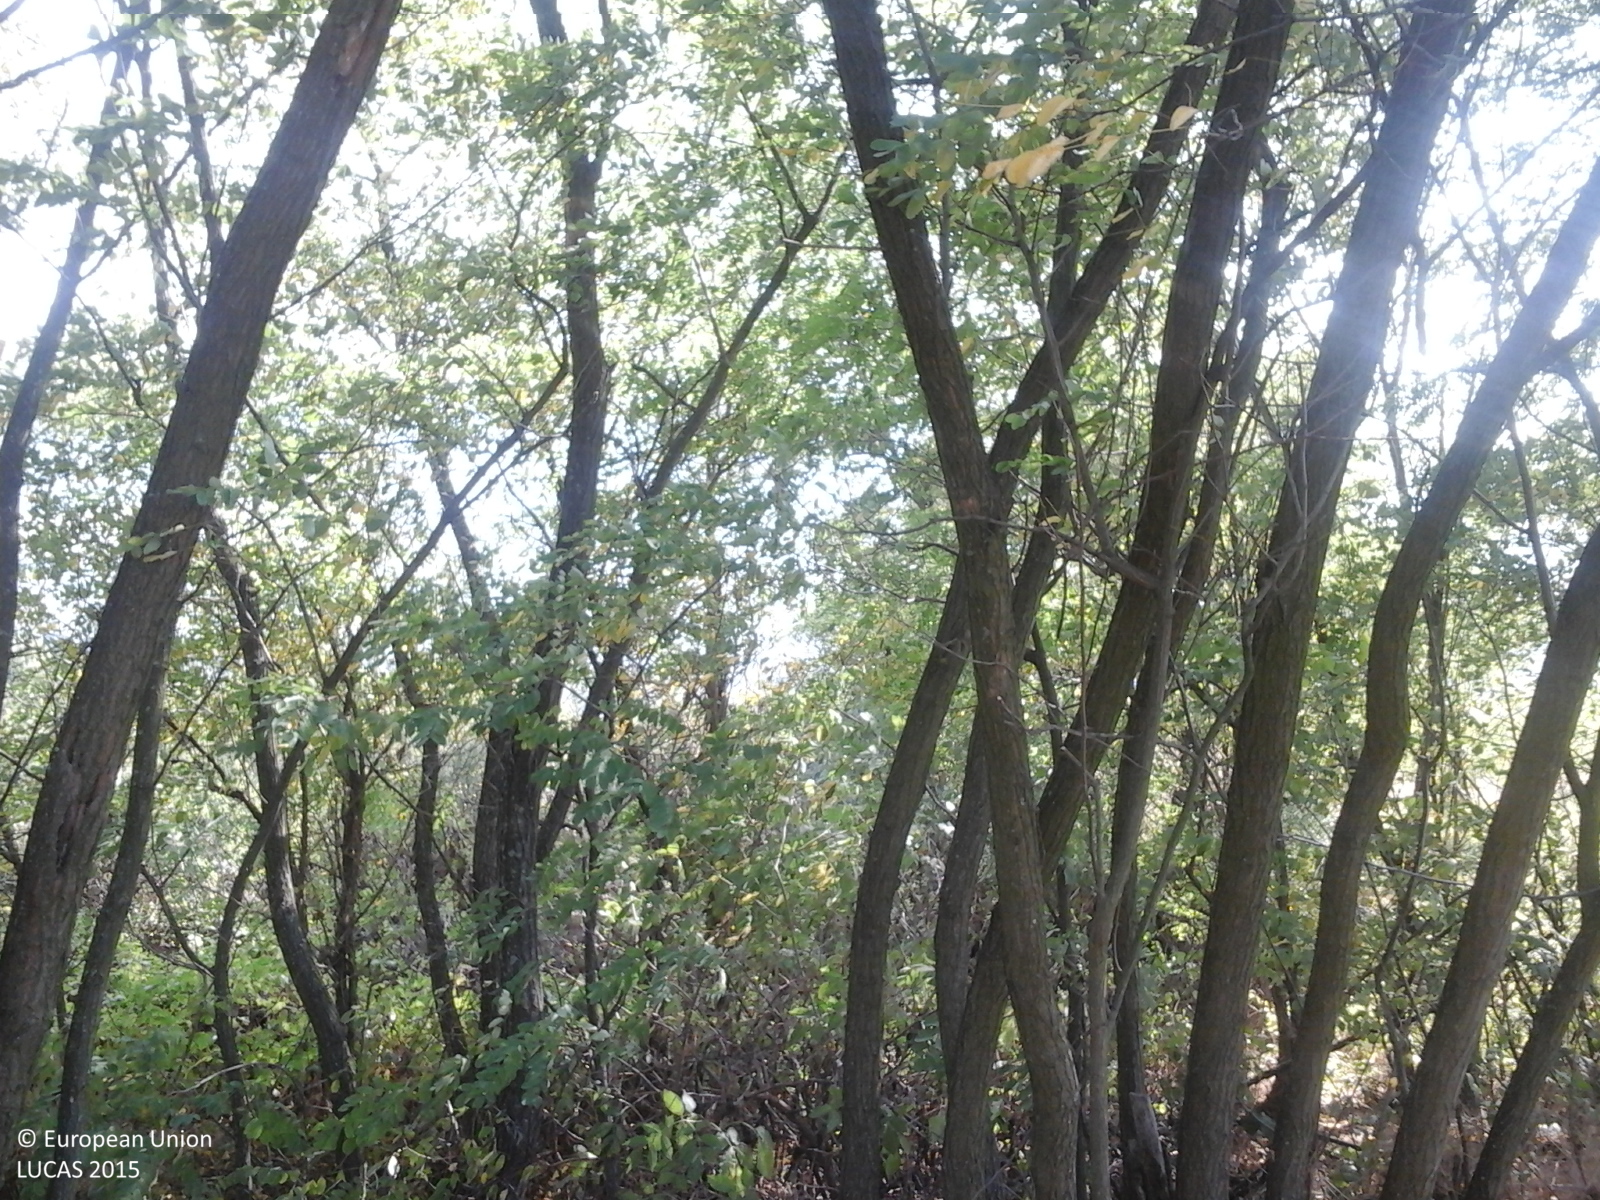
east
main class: Grassland
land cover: Grassland with sparse tree/shrub cover
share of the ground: > 75 %
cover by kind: herbaceous plants 85 %, shrubs 10 %, broadleaved forest trees 5 %
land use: Agriculture (excluding fallow land and kitchen gardens)
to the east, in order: Grassland with sparse tree/shrub cover; Broadleaved woodland; Tracks; Grassland without tree/shrub cover; Other fruit trees and berries; Tracks; Other fruit trees and berries; Spontaneously vegetated surfaces; Other fruit trees and berries
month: September
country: RO
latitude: 45.0739
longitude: 22.2973
